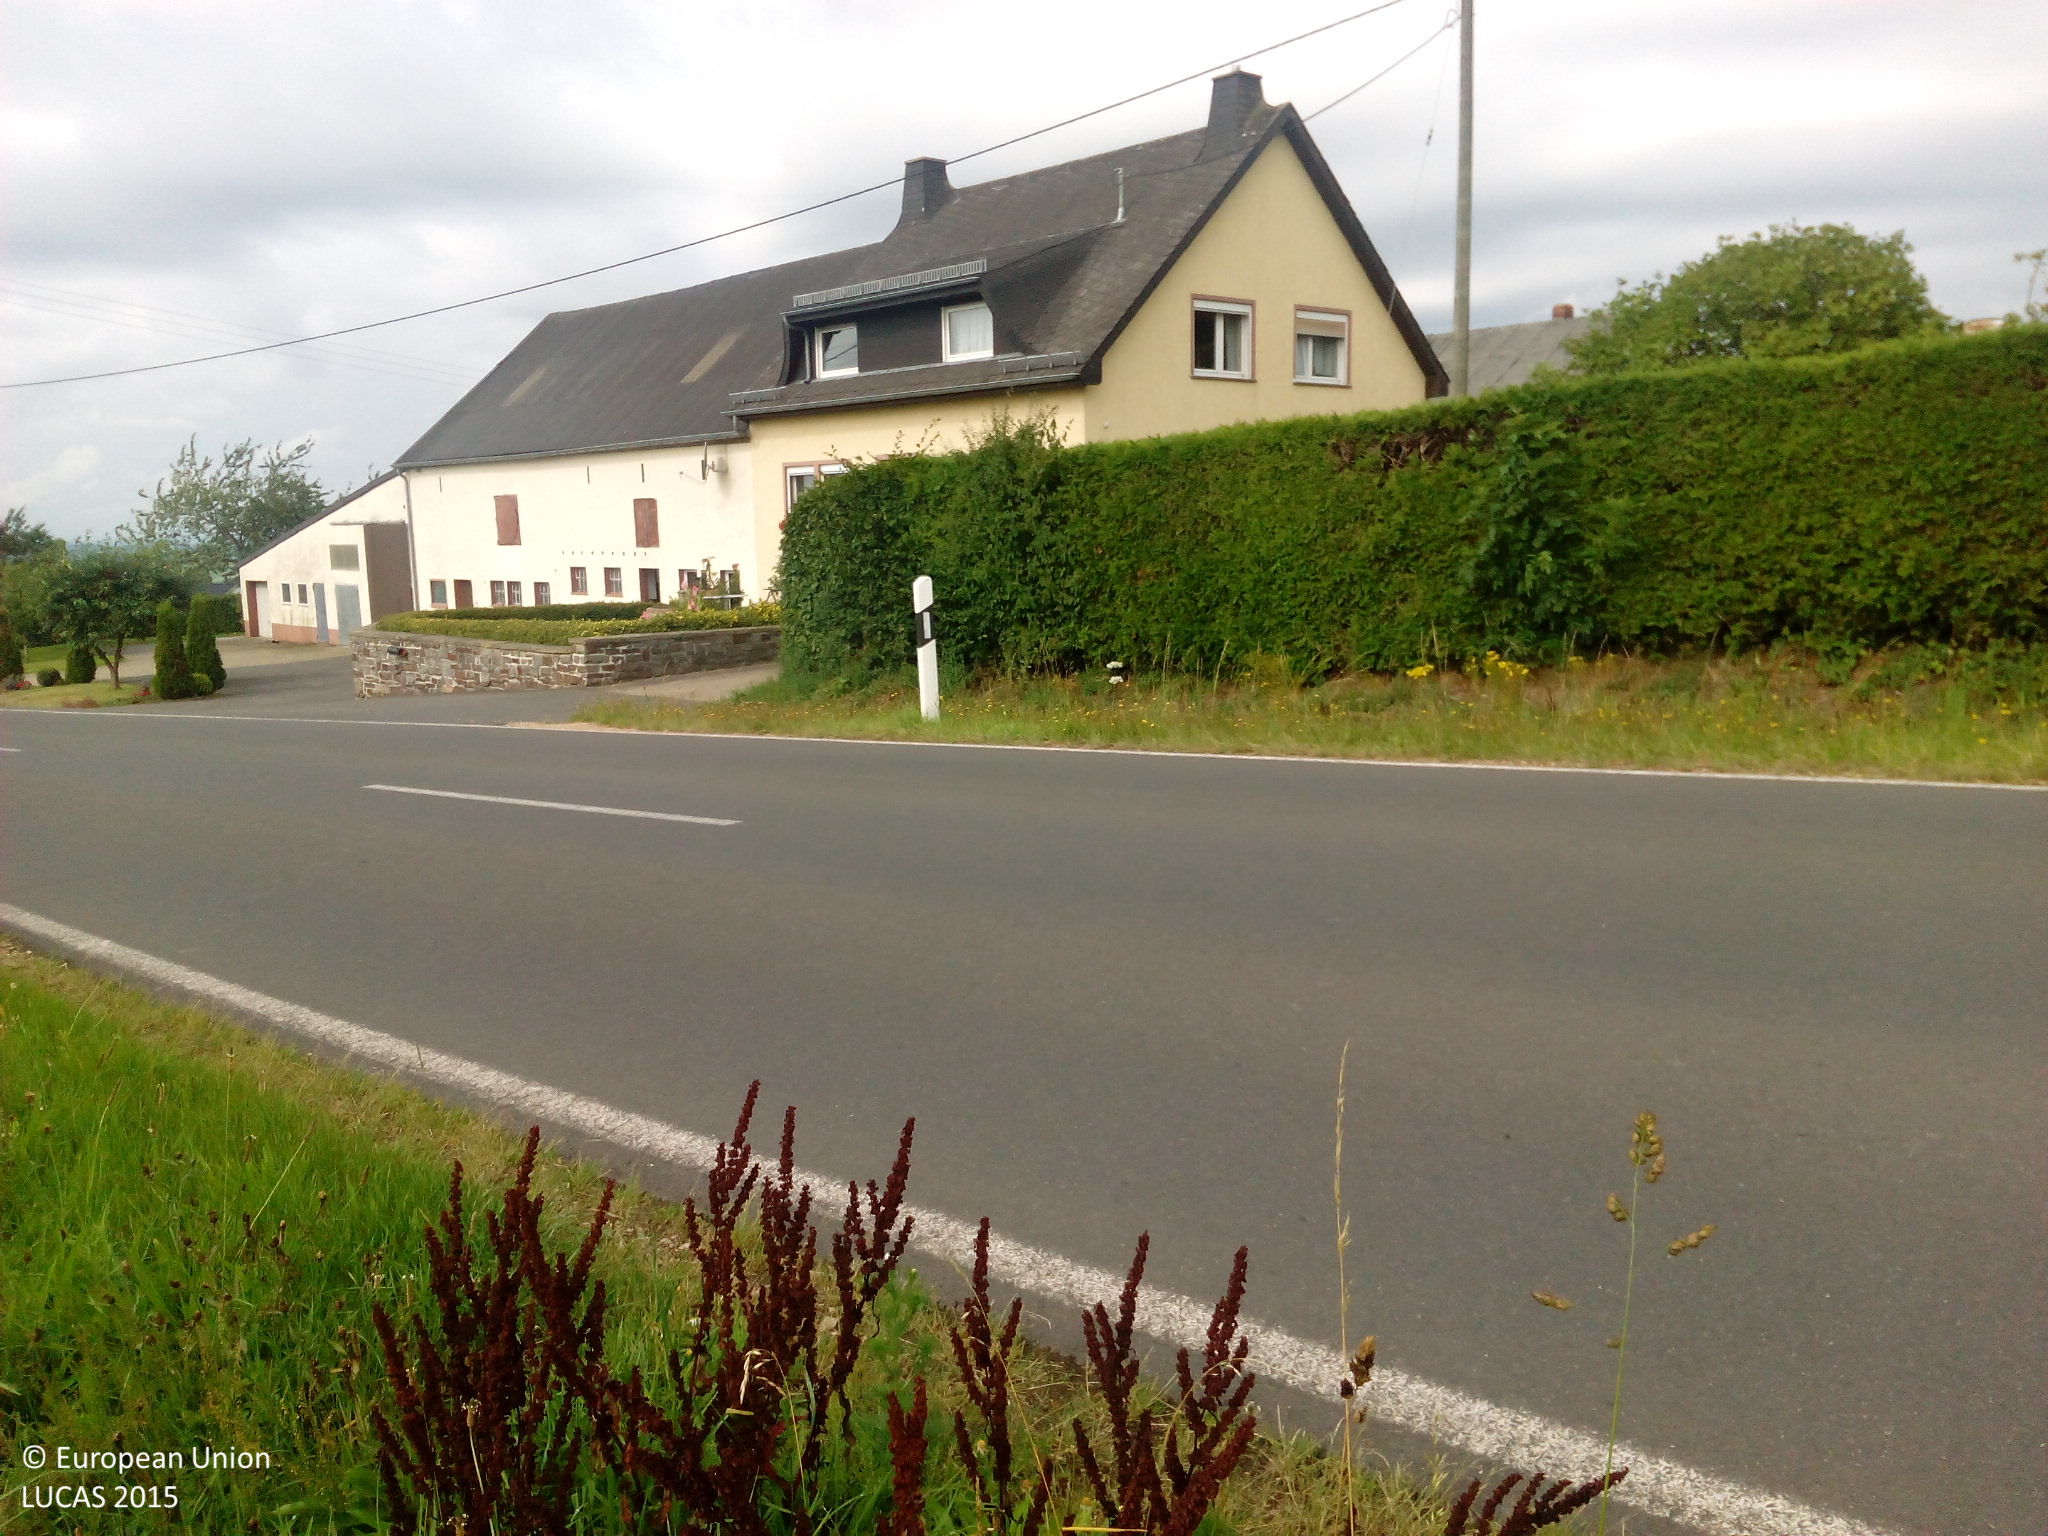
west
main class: Cropland
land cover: Maize
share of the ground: > 75 %
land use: Agriculture (excluding fallow land and kitchen gardens)
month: August
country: DE
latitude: 50.2497
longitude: 6.2830
